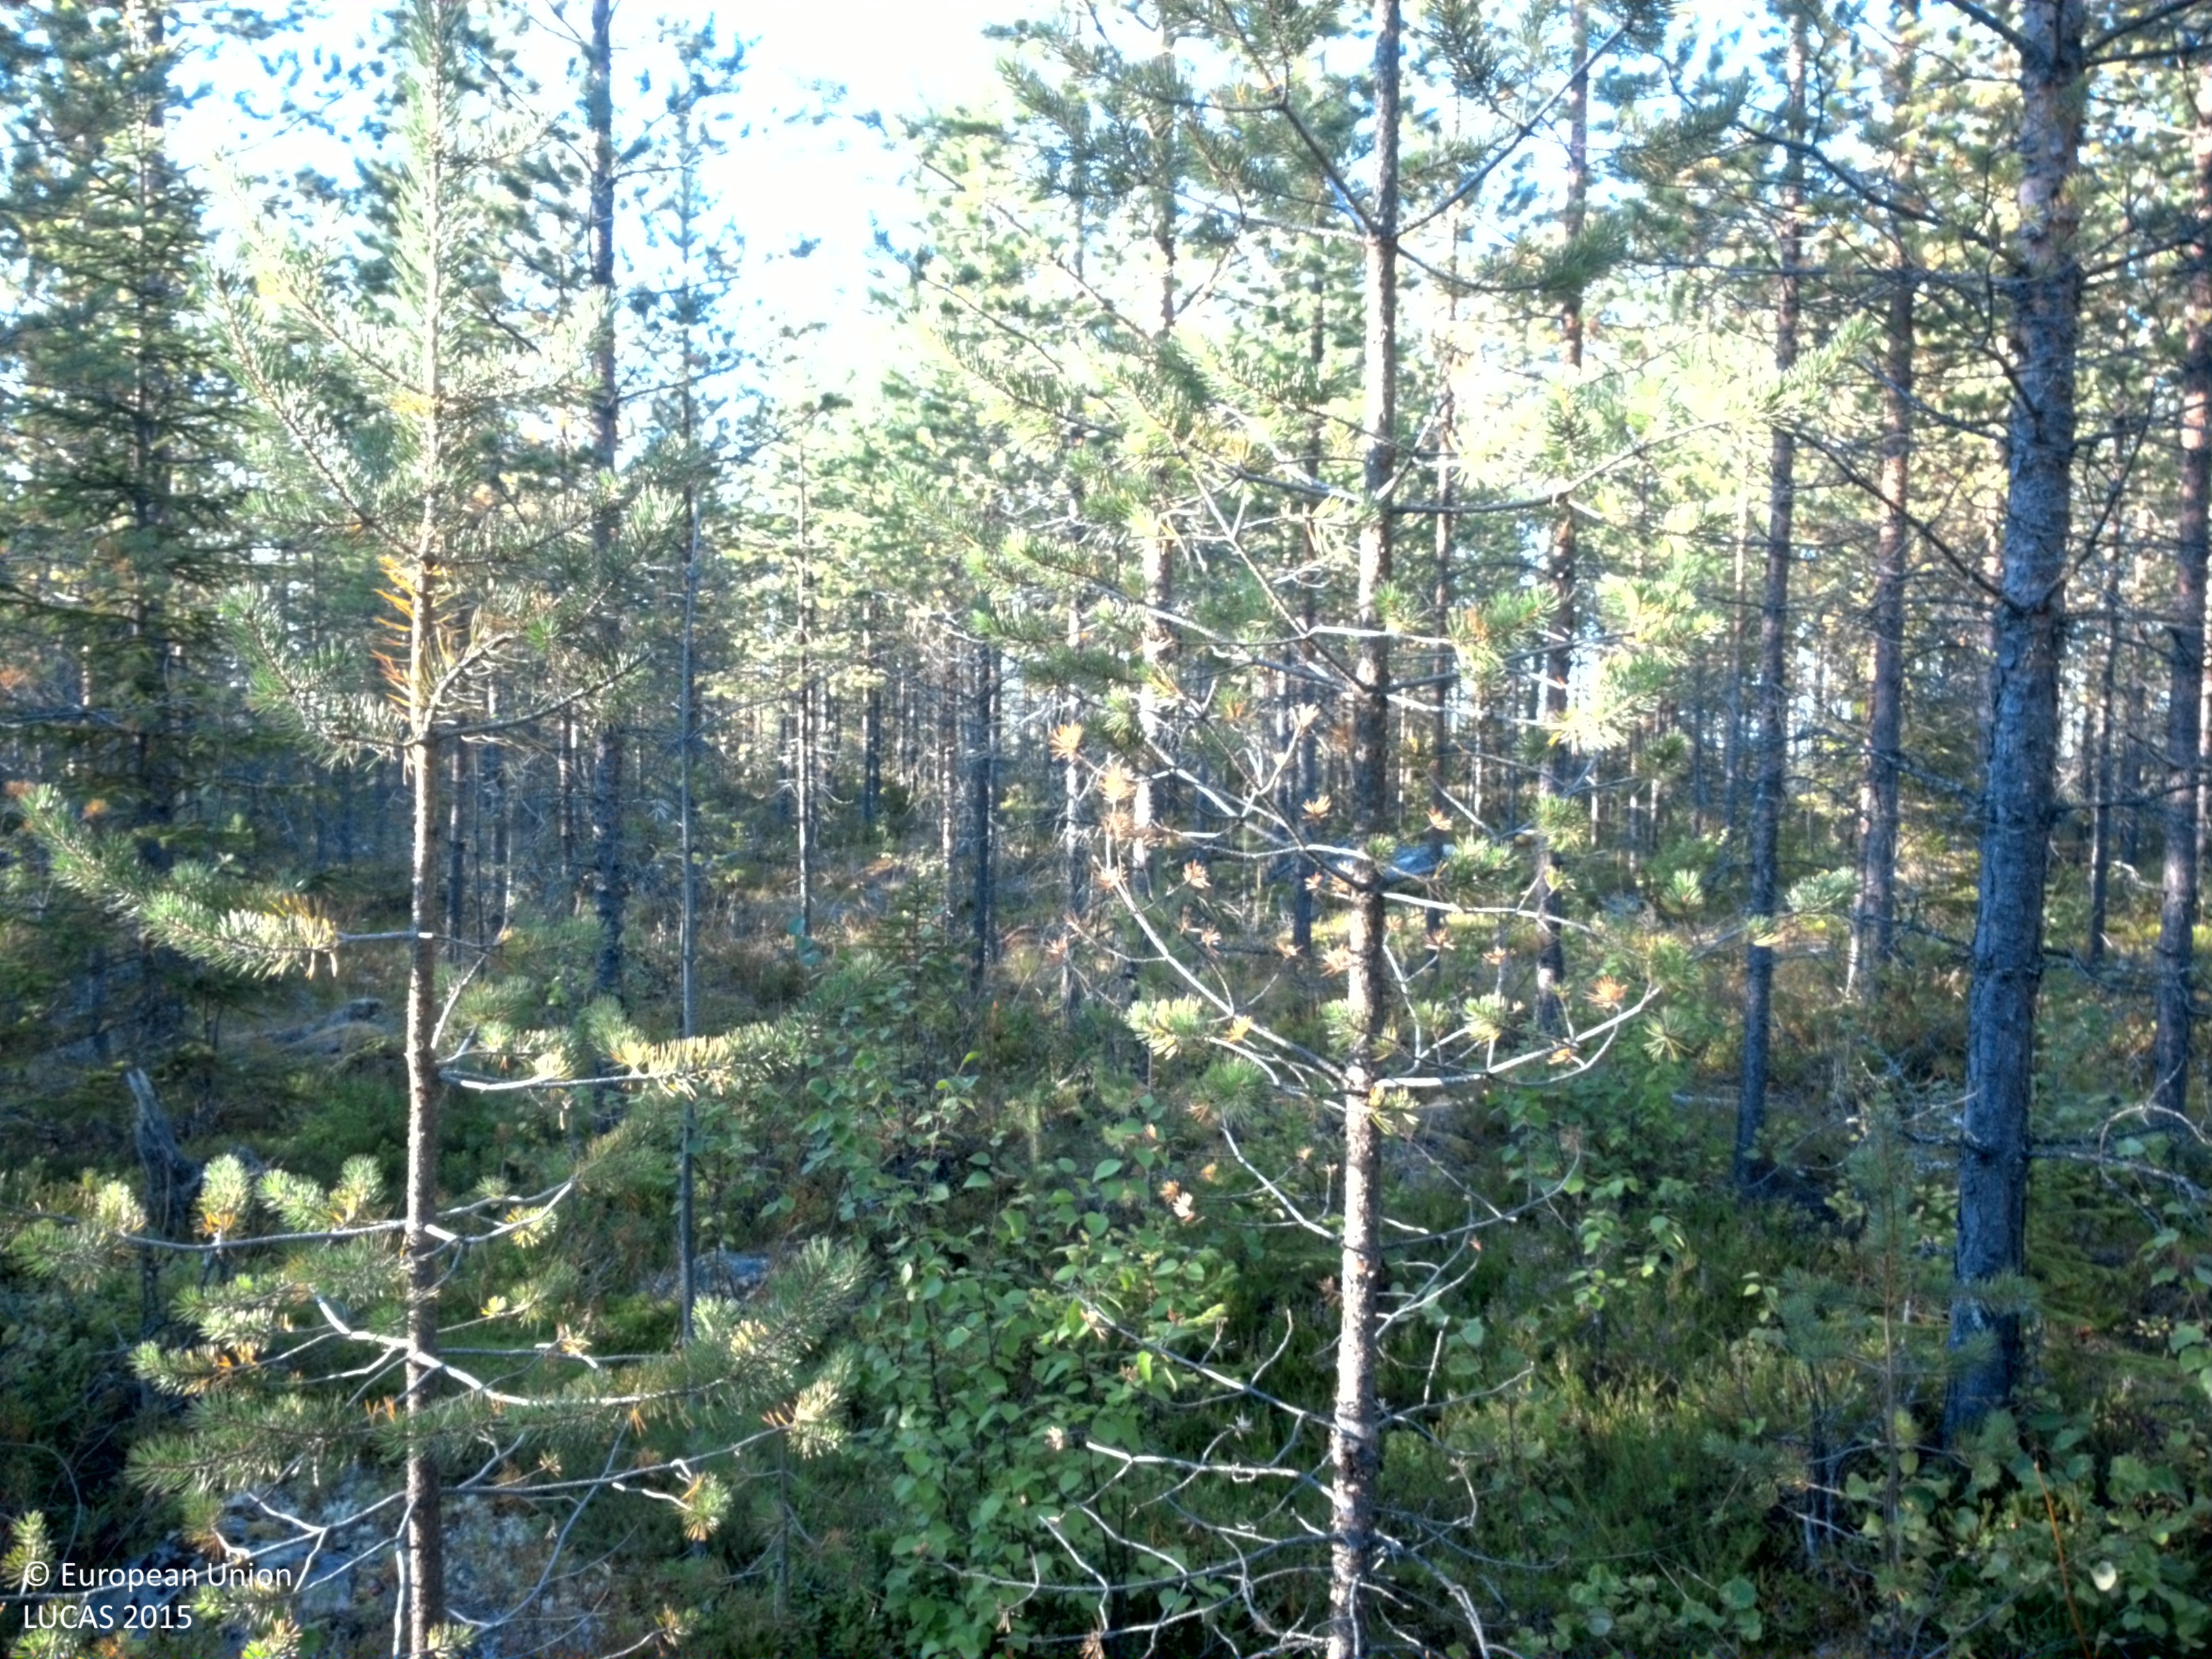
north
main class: Woodland
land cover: Pine dominated coniferous woodland
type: boreal forest
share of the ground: 50 - 75 %
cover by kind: coniferous forest trees 55 %, shrubs 40 %, broadleaved forest trees 5 %
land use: Forestry
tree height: > 5 m
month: August
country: SE
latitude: 64.3952
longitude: 19.0337
